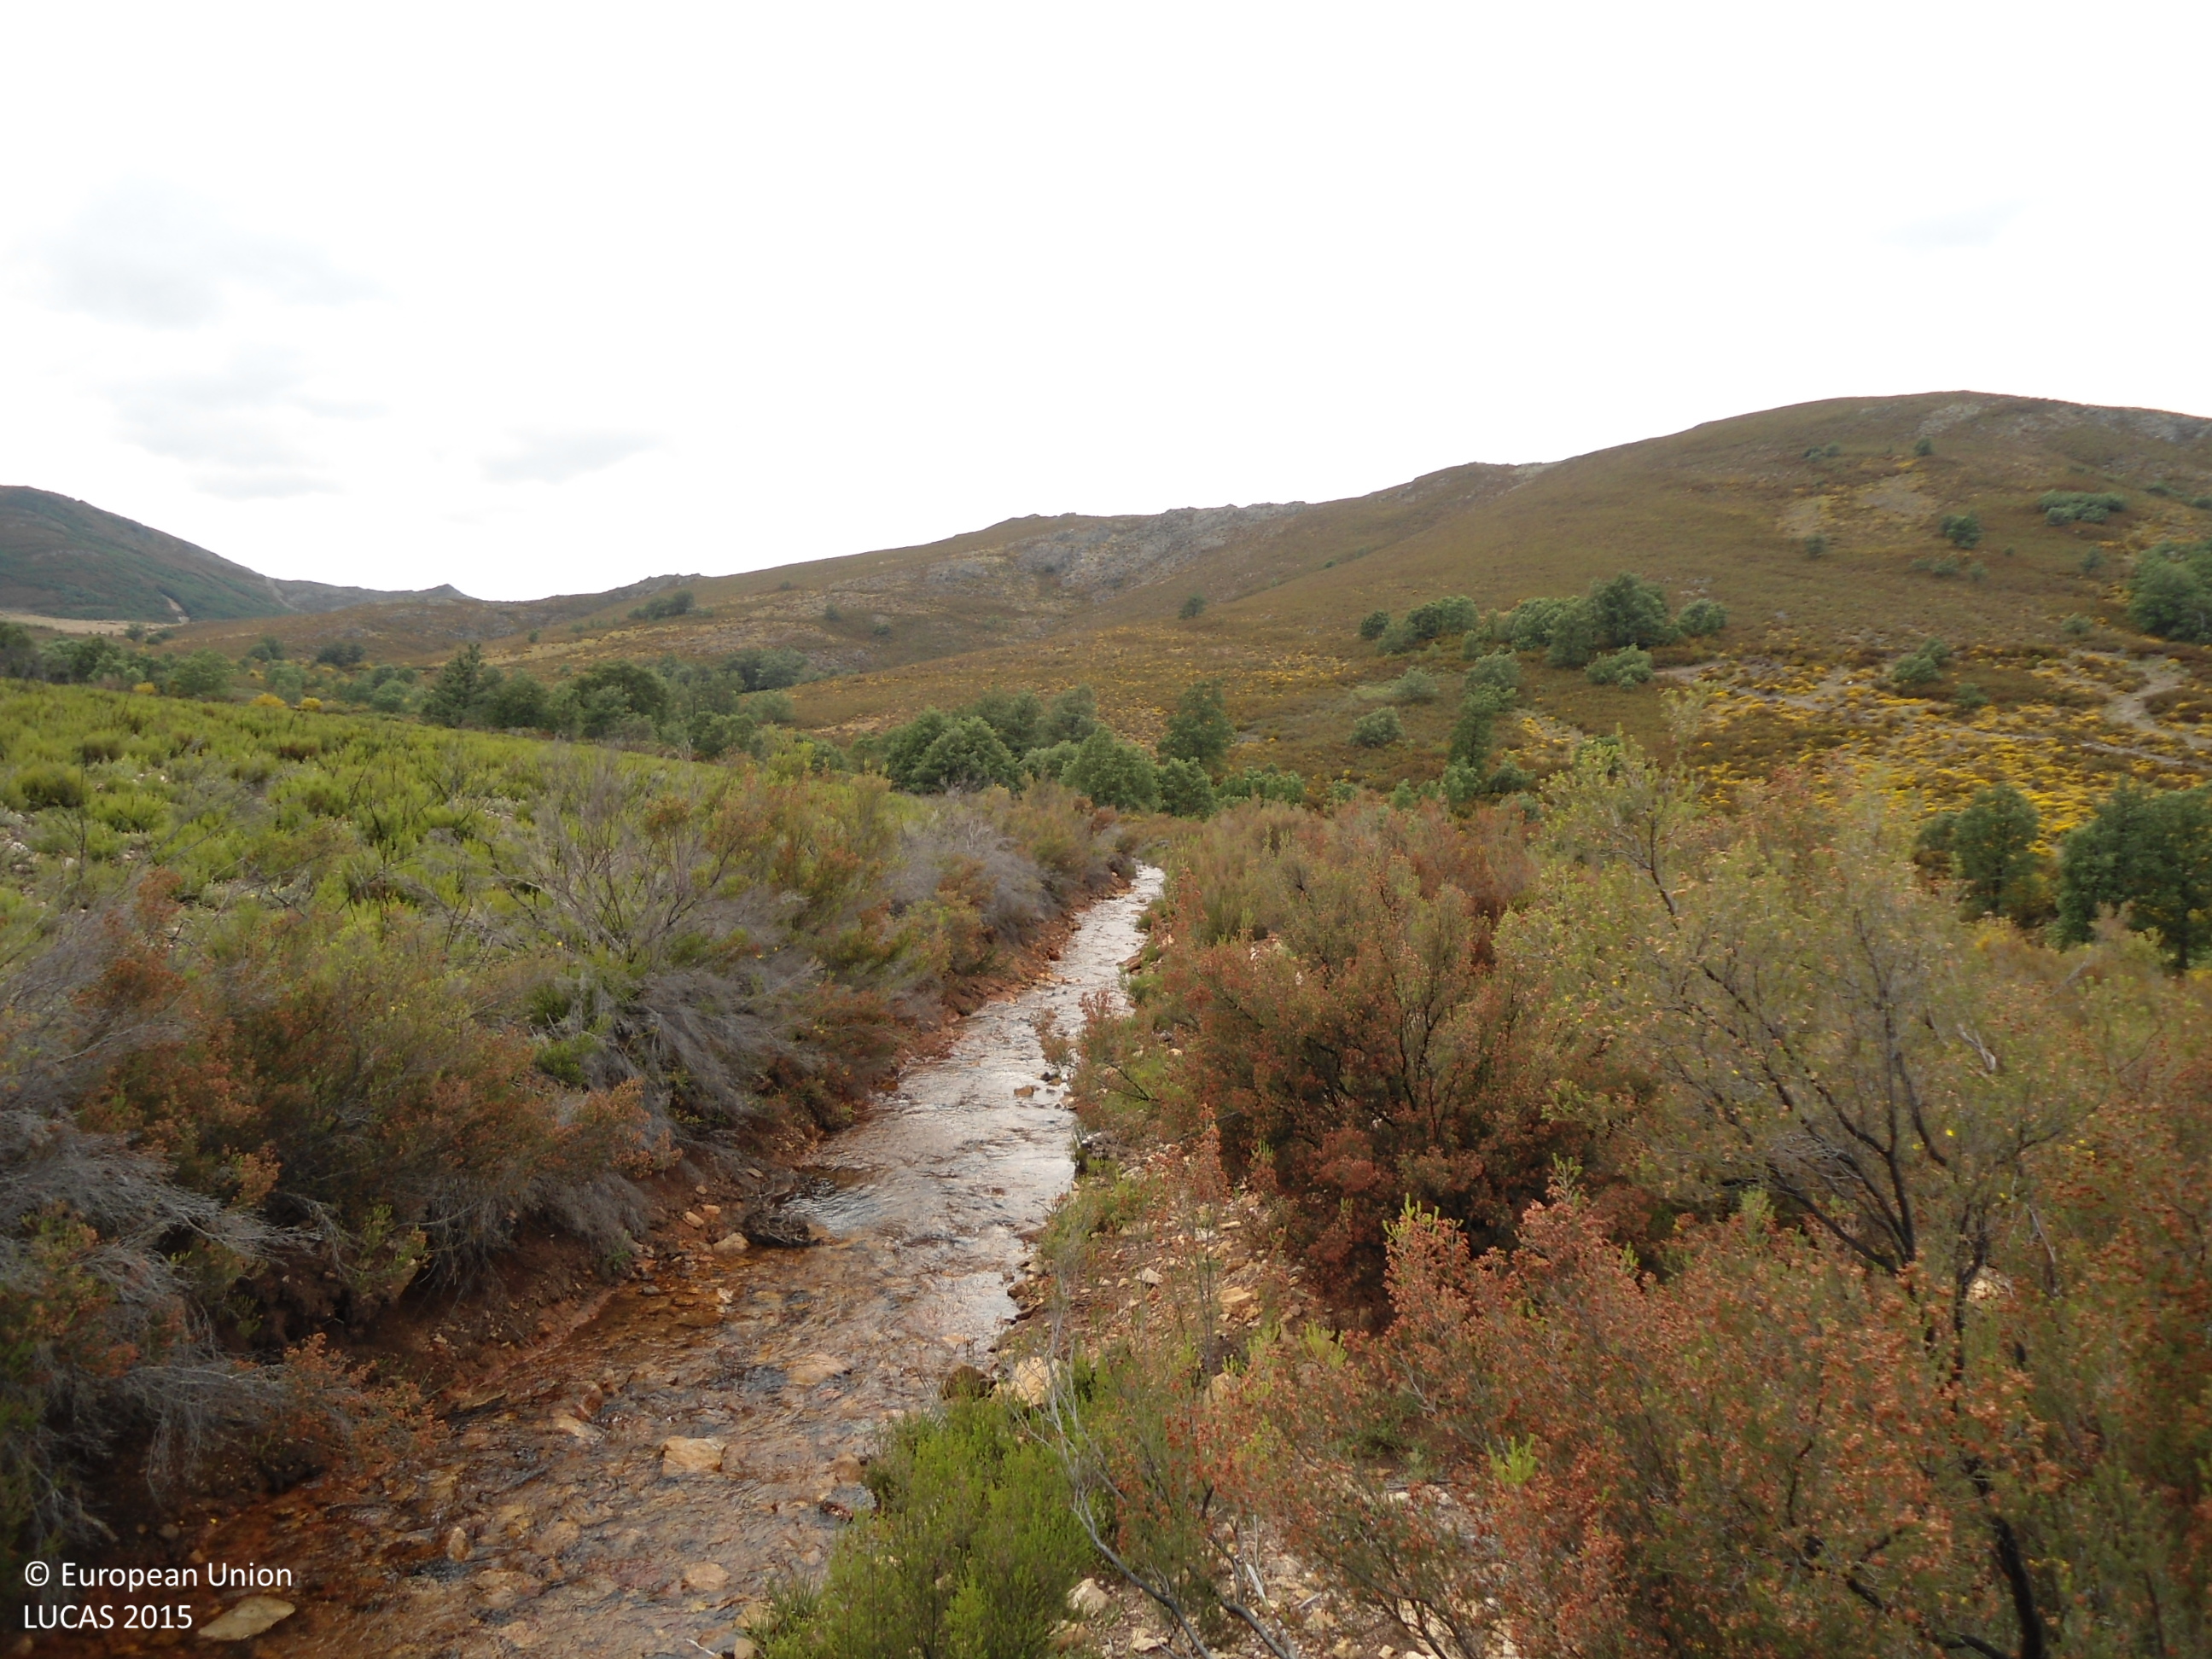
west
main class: Woodland
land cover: Broadleaved woodland
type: floodplain forest
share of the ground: > 75 %
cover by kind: broadleaved forest trees 90 %, shrubs 10 %
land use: Semi-natural and natural areas not in use
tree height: > 5 m
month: June
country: ES
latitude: 42.2114
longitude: -6.3776
